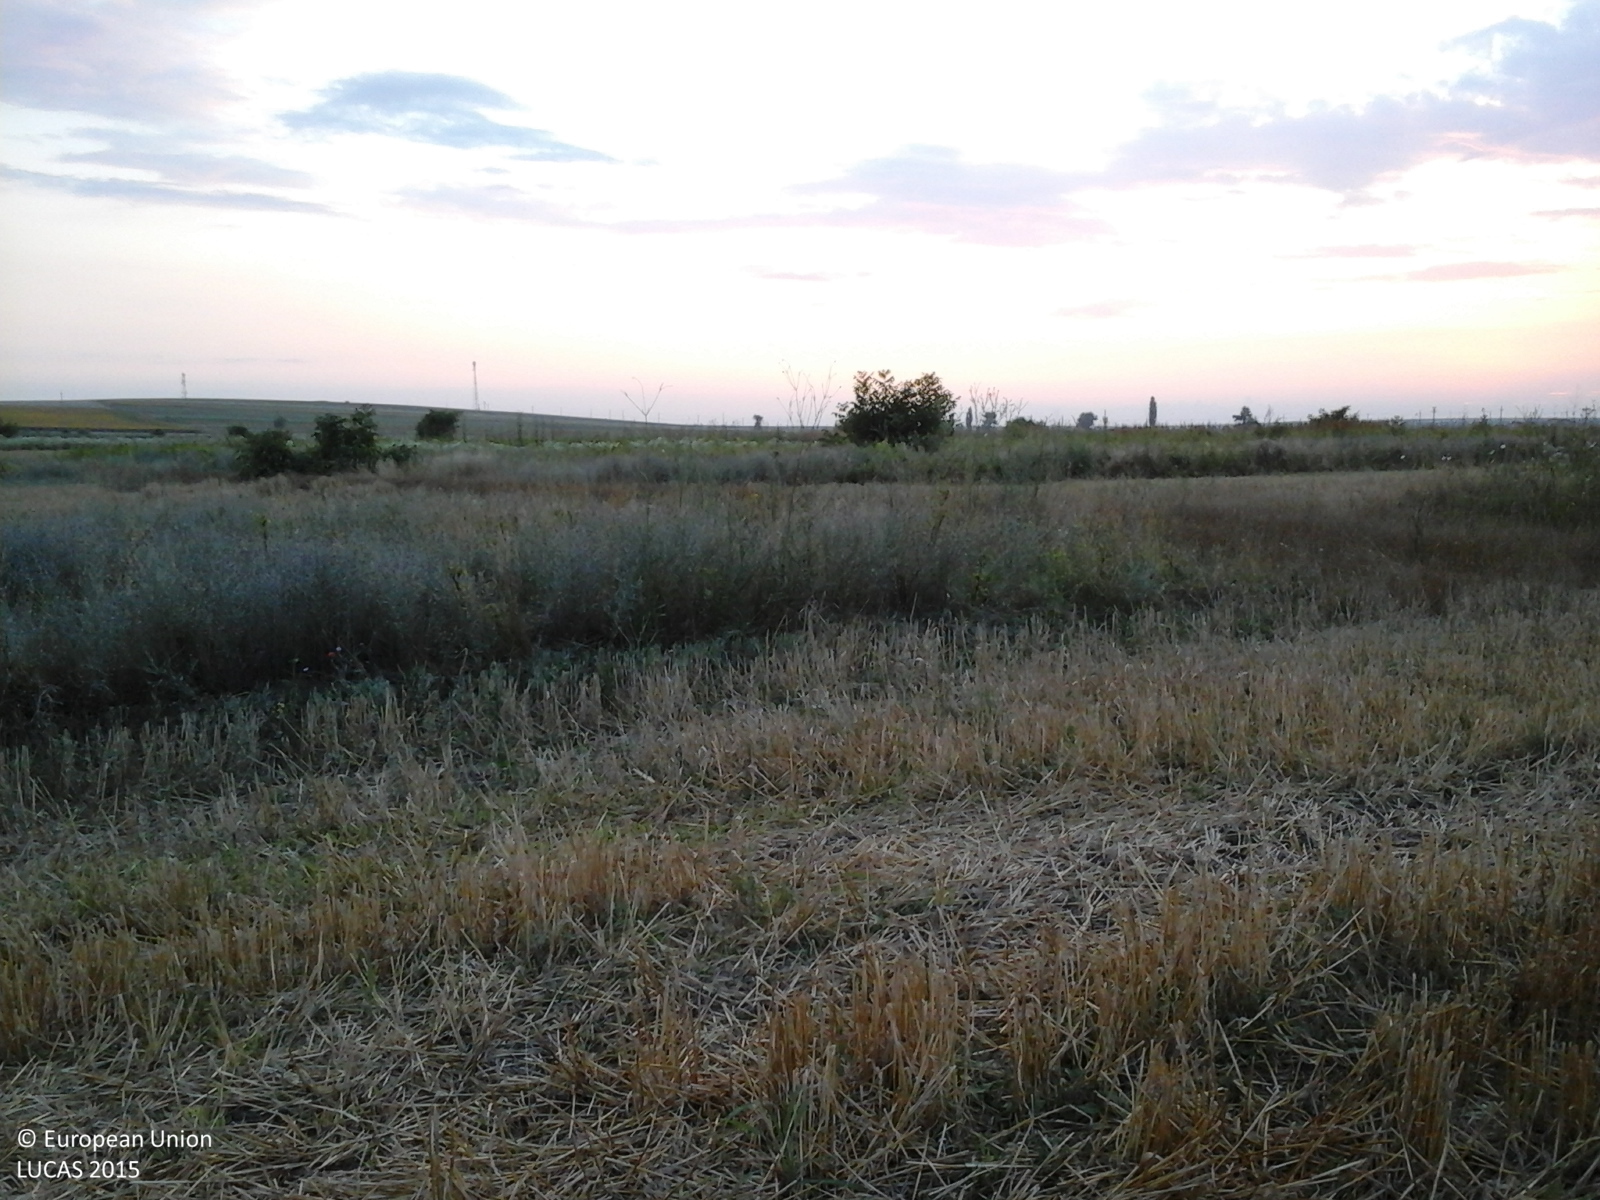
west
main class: Cropland
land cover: Common wheat
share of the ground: < 10 %
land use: Agriculture (excluding fallow land and kitchen gardens)
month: July
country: RO
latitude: 43.8283
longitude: 25.4411
